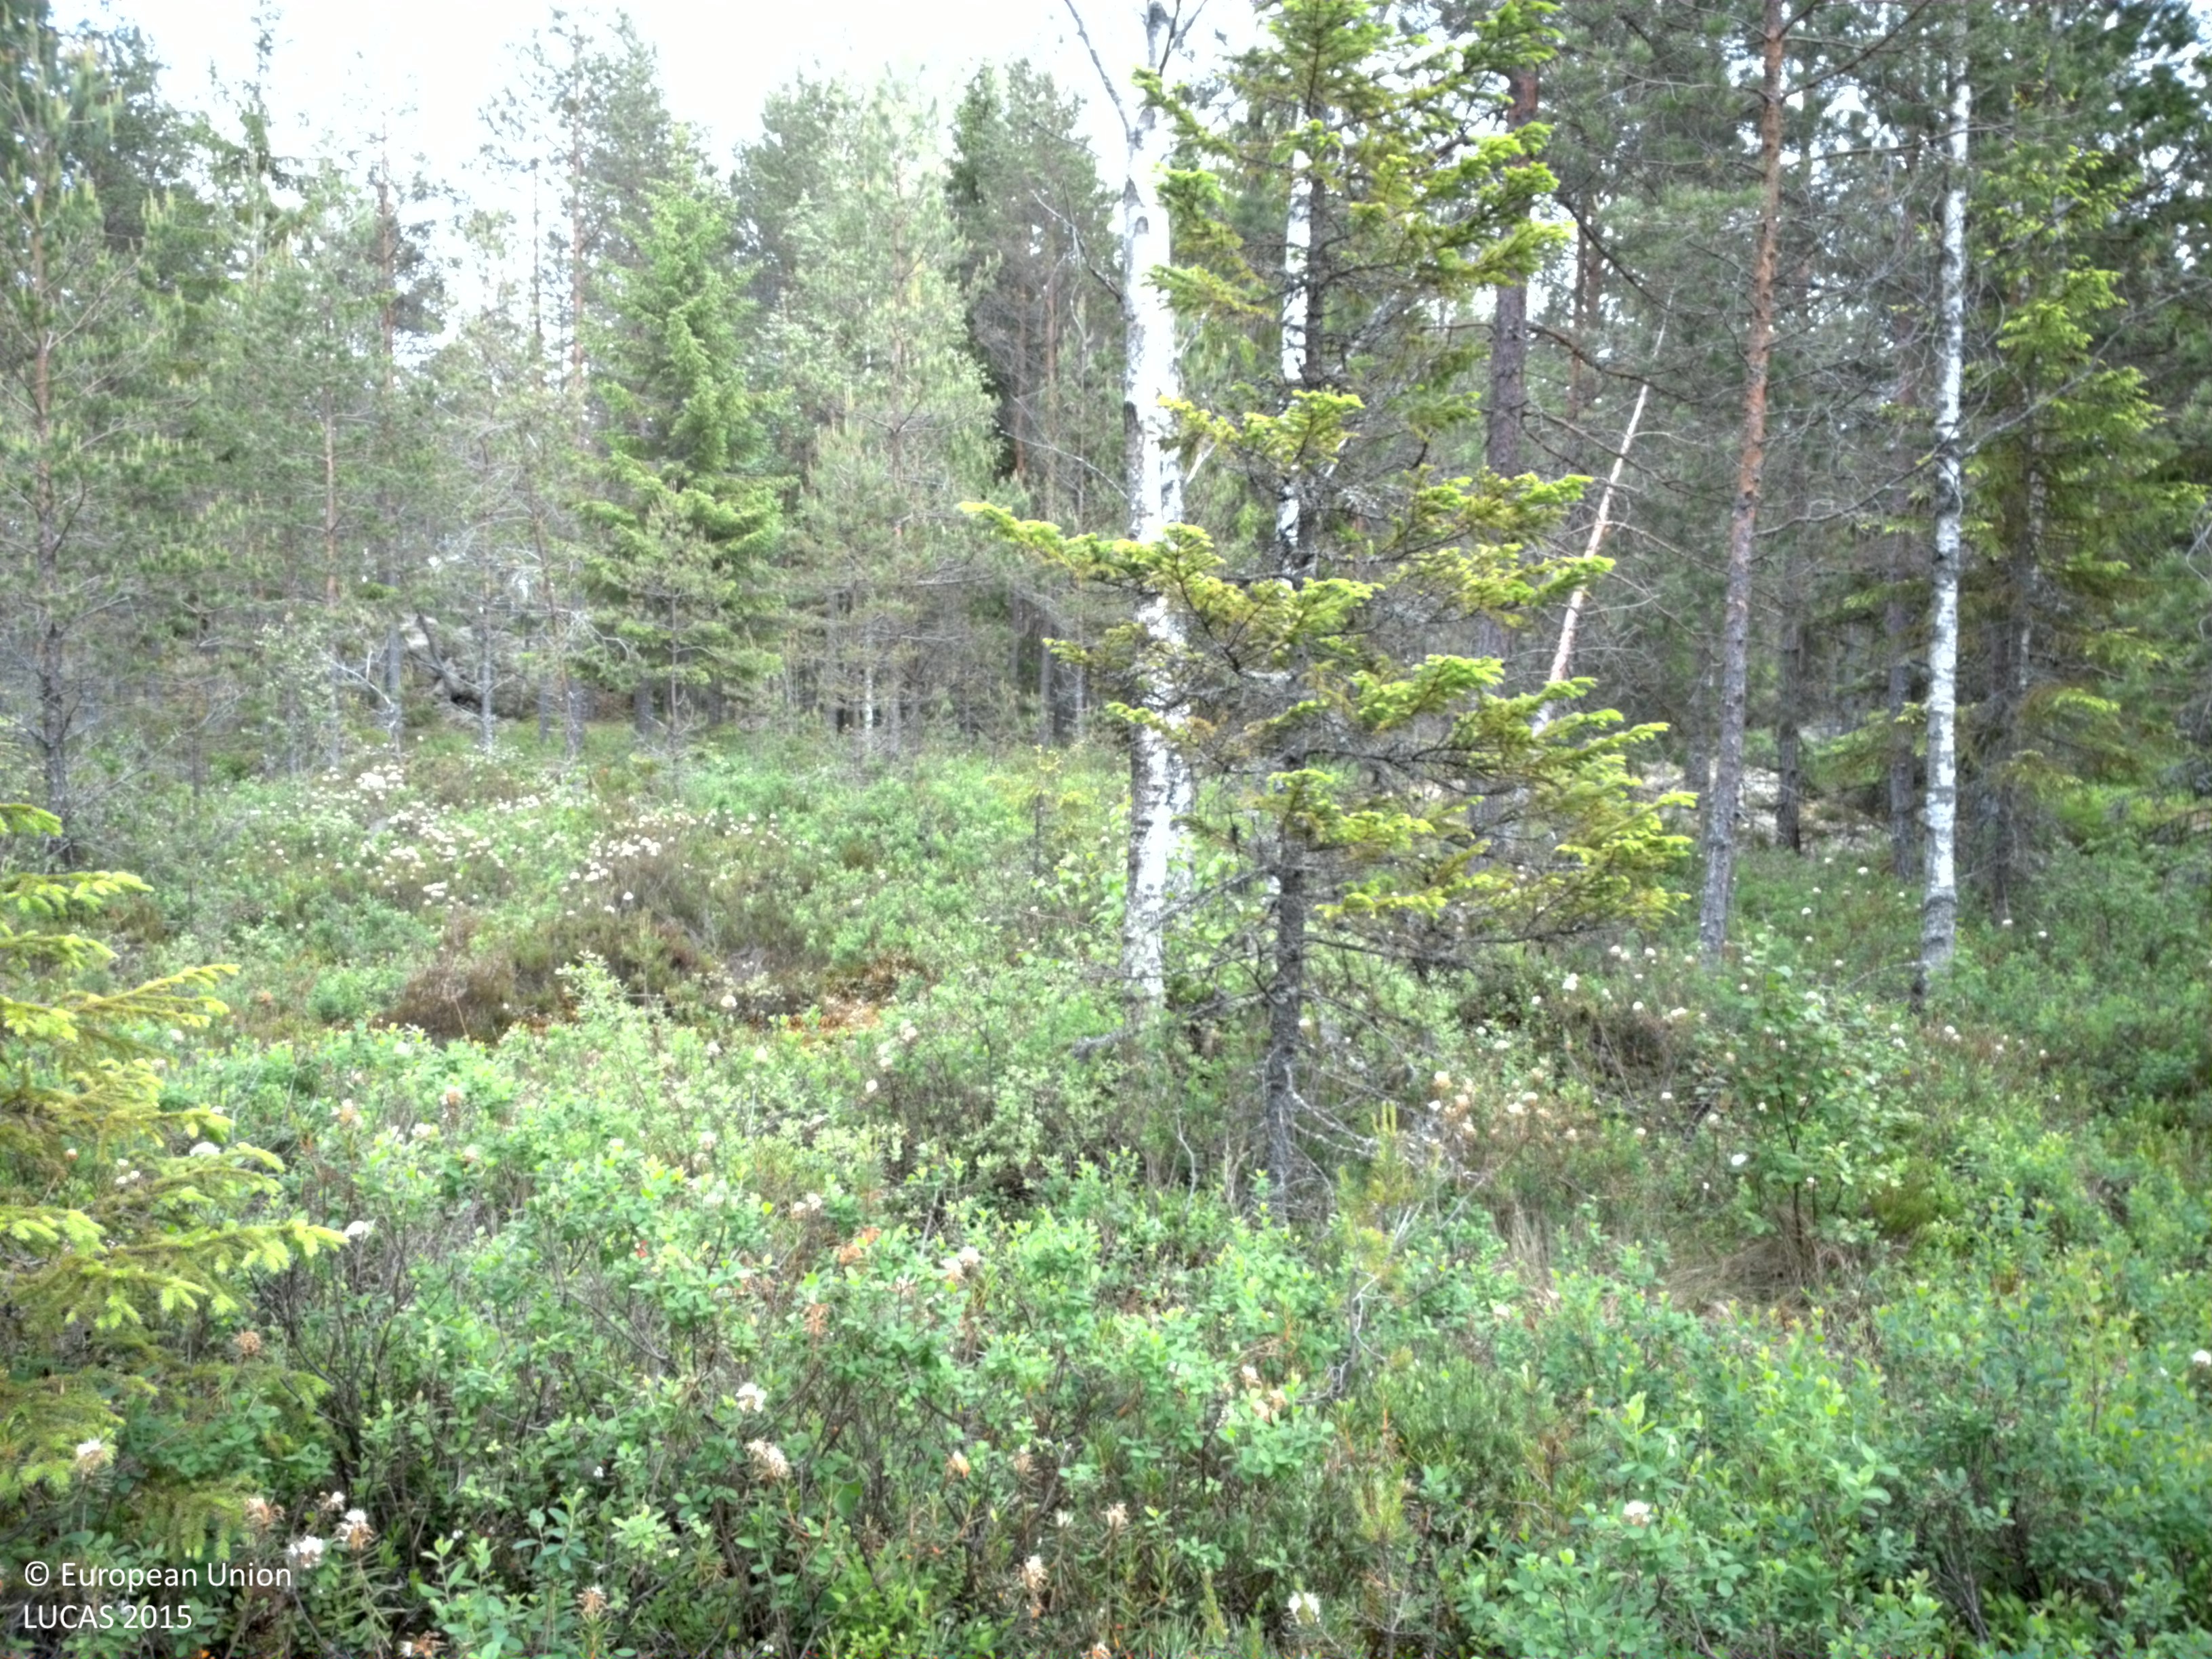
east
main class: Woodland
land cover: Pine dominated coniferous woodland
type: boreal forest
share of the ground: 25 - 50 %
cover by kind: coniferous forest trees 45 %, lichens and mosses 30 %, shrubs 20 %, broadleaved forest trees 5 %
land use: Forestry
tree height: > 5 m
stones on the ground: < 10 %
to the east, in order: Pine dominated coniferous woodland; Tracks; Pine dominated coniferous woodland; Ditches and canals; Paved roads, cycling and walking lanes; Electric lines; Ditches and canals; Spruce dominated coniferous woodland; Pine dominated coniferous woodland
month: June
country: SE
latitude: 59.9977
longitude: 17.1817
